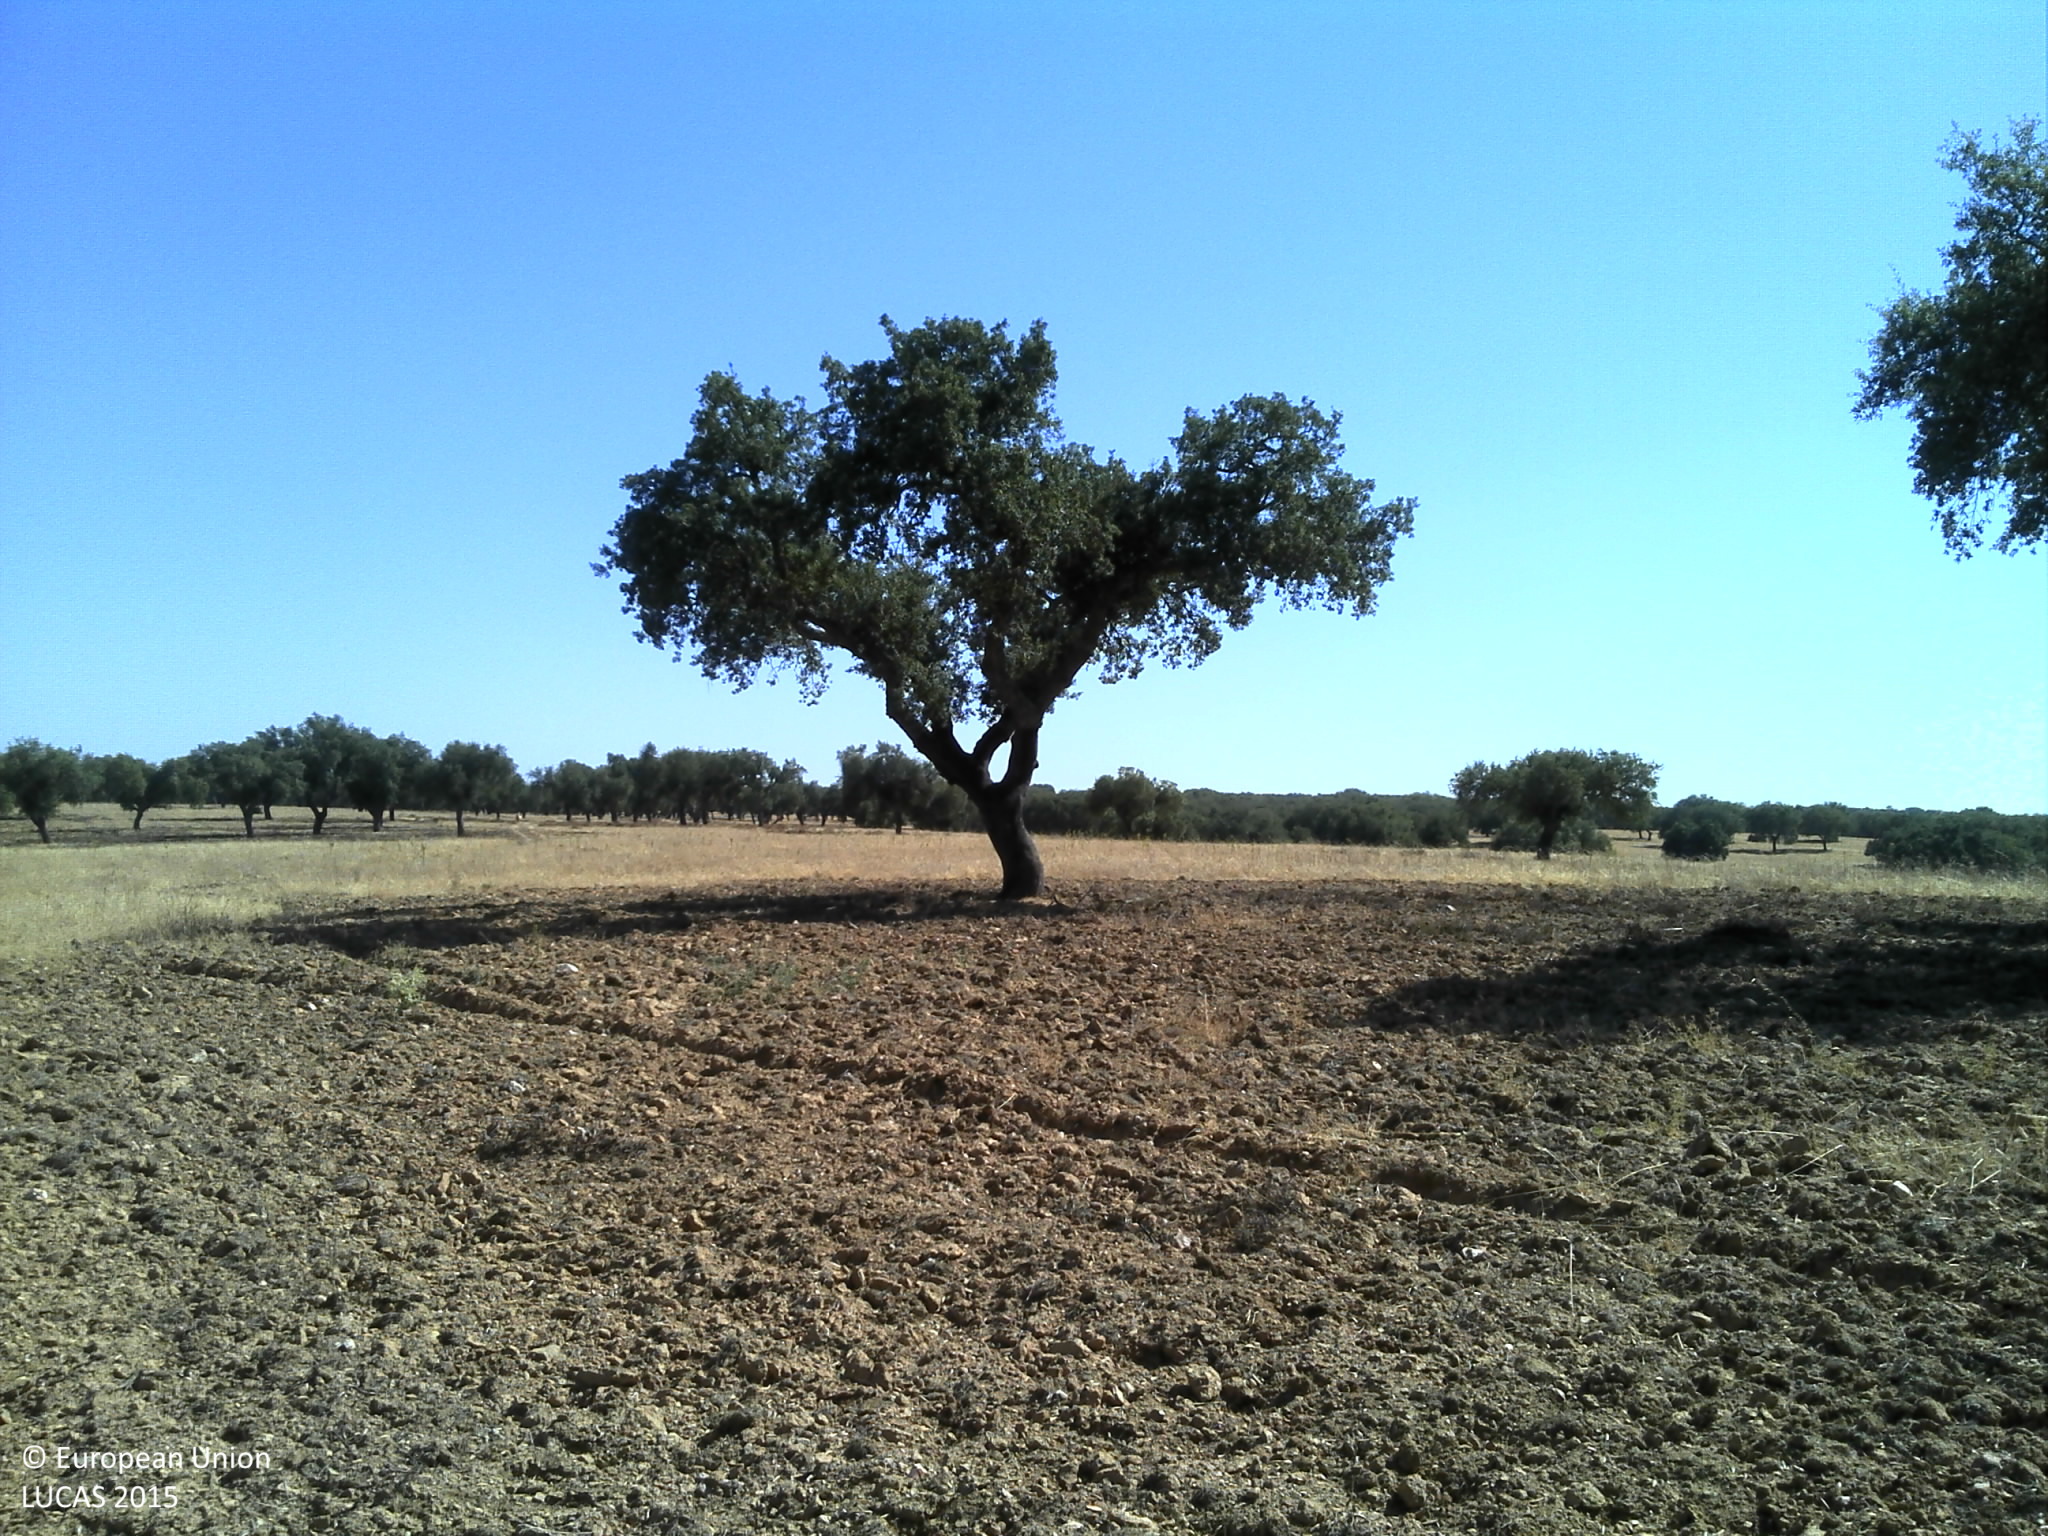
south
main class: Woodland
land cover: Broadleaved woodland
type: broadleaved evergreen forest
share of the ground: 10 - 25 %
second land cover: Grassland without tree/shrub cover
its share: < 10 %
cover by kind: unconsolidated bare surface 75 %, broadleaved forest trees 15 %, herbaceous plants 10 %
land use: Forestry
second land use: Agriculture (excluding fallow land and kitchen gardens)
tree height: > 5 m
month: July
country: PT
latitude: 38.8867
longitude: -7.3831
